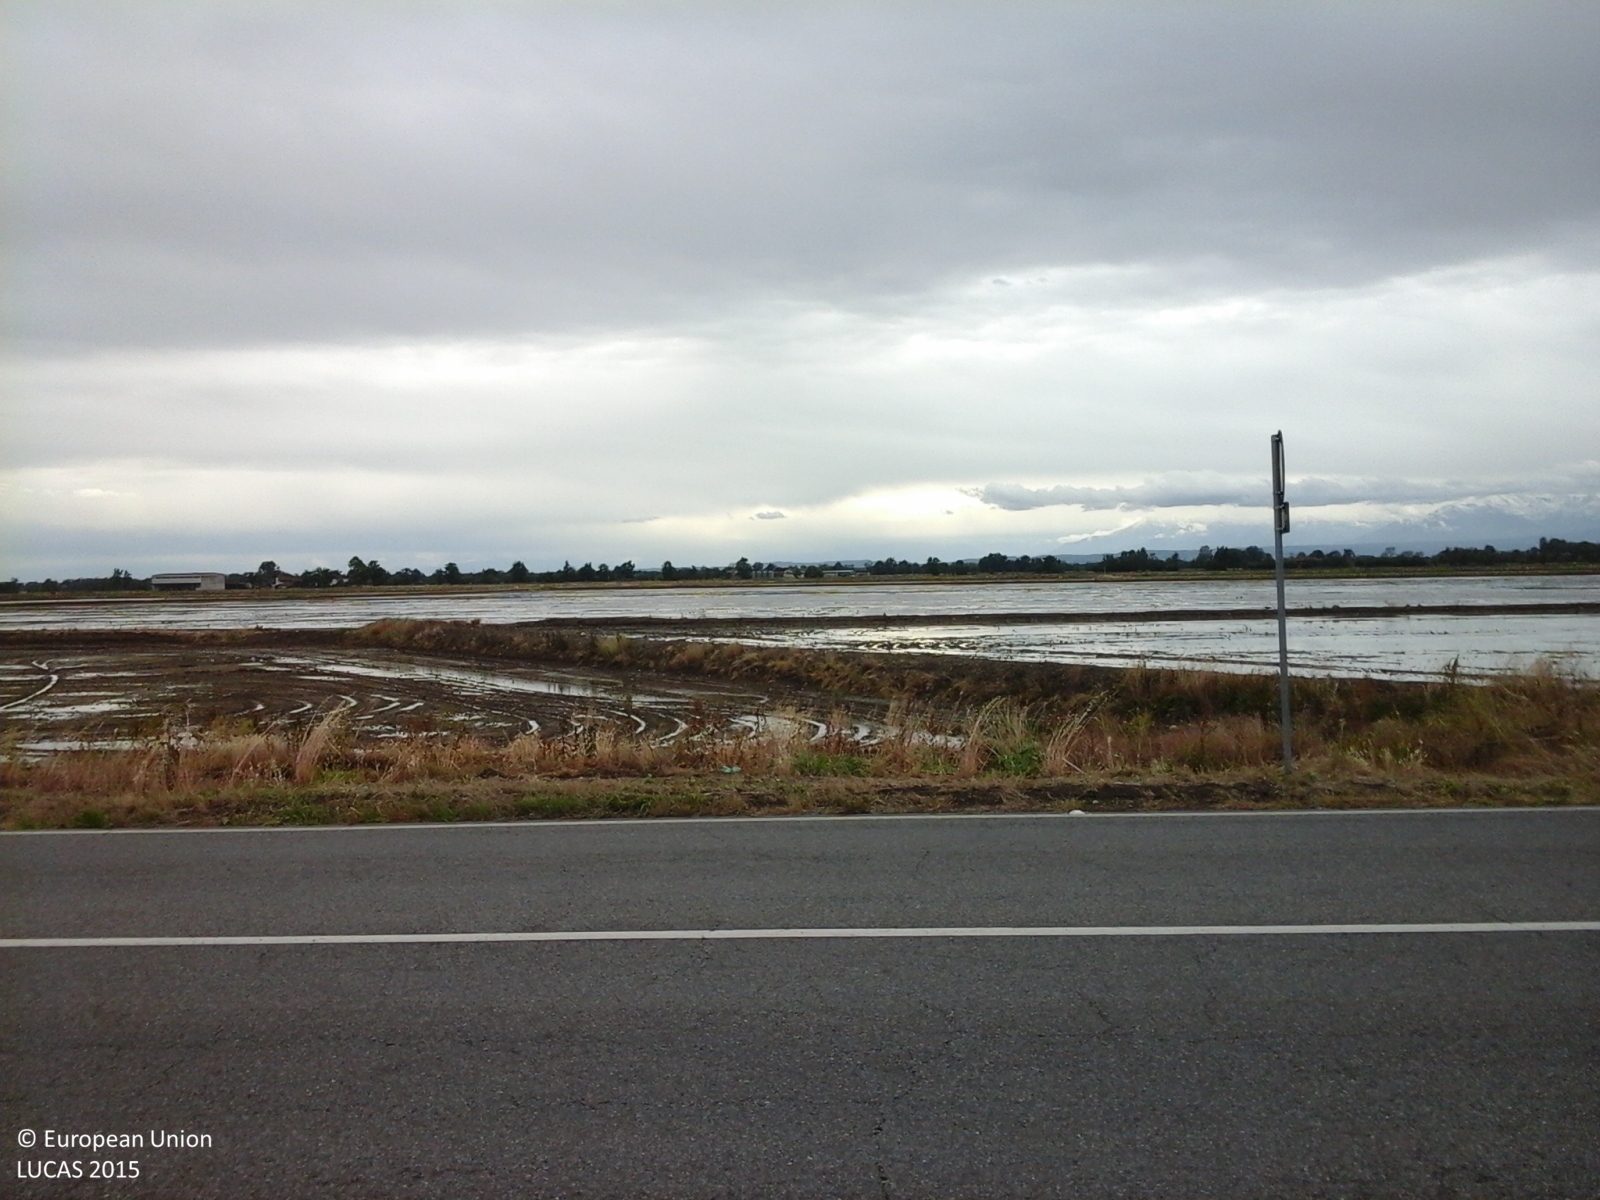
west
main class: Grassland
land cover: Grassland without tree/shrub cover
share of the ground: > 75 %
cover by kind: herbaceous plants 85 %, consolidated bare surface 15 %
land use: Road transport
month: May
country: IT
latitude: 45.4199
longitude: 8.3797
